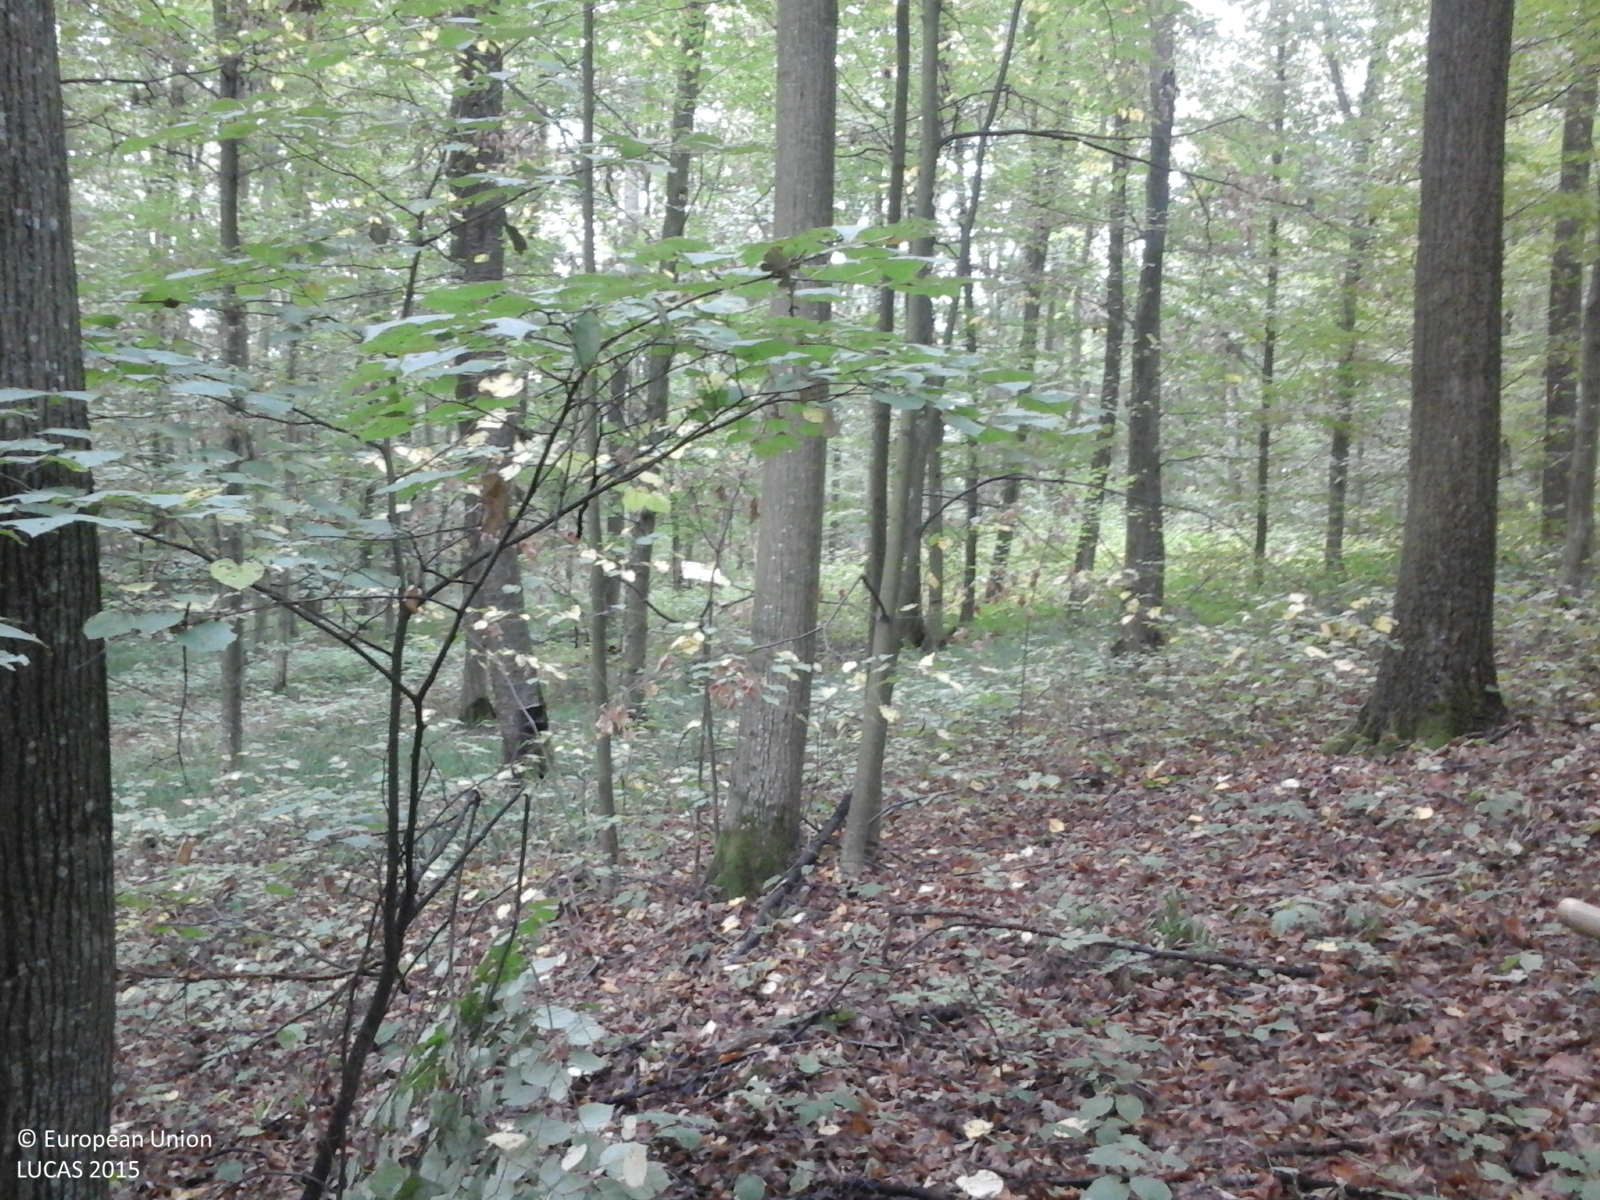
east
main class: Woodland
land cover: Broadleaved woodland
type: mesophytic deciduous forest
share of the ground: > 75 %
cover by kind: broadleaved forest trees 100 %
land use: Forestry
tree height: > 5 m
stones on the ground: 10 - 25 %
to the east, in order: Broadleaved woodland; Tracks; Broadleaved woodland
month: September
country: RO
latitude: 45.9049
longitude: 22.1993
